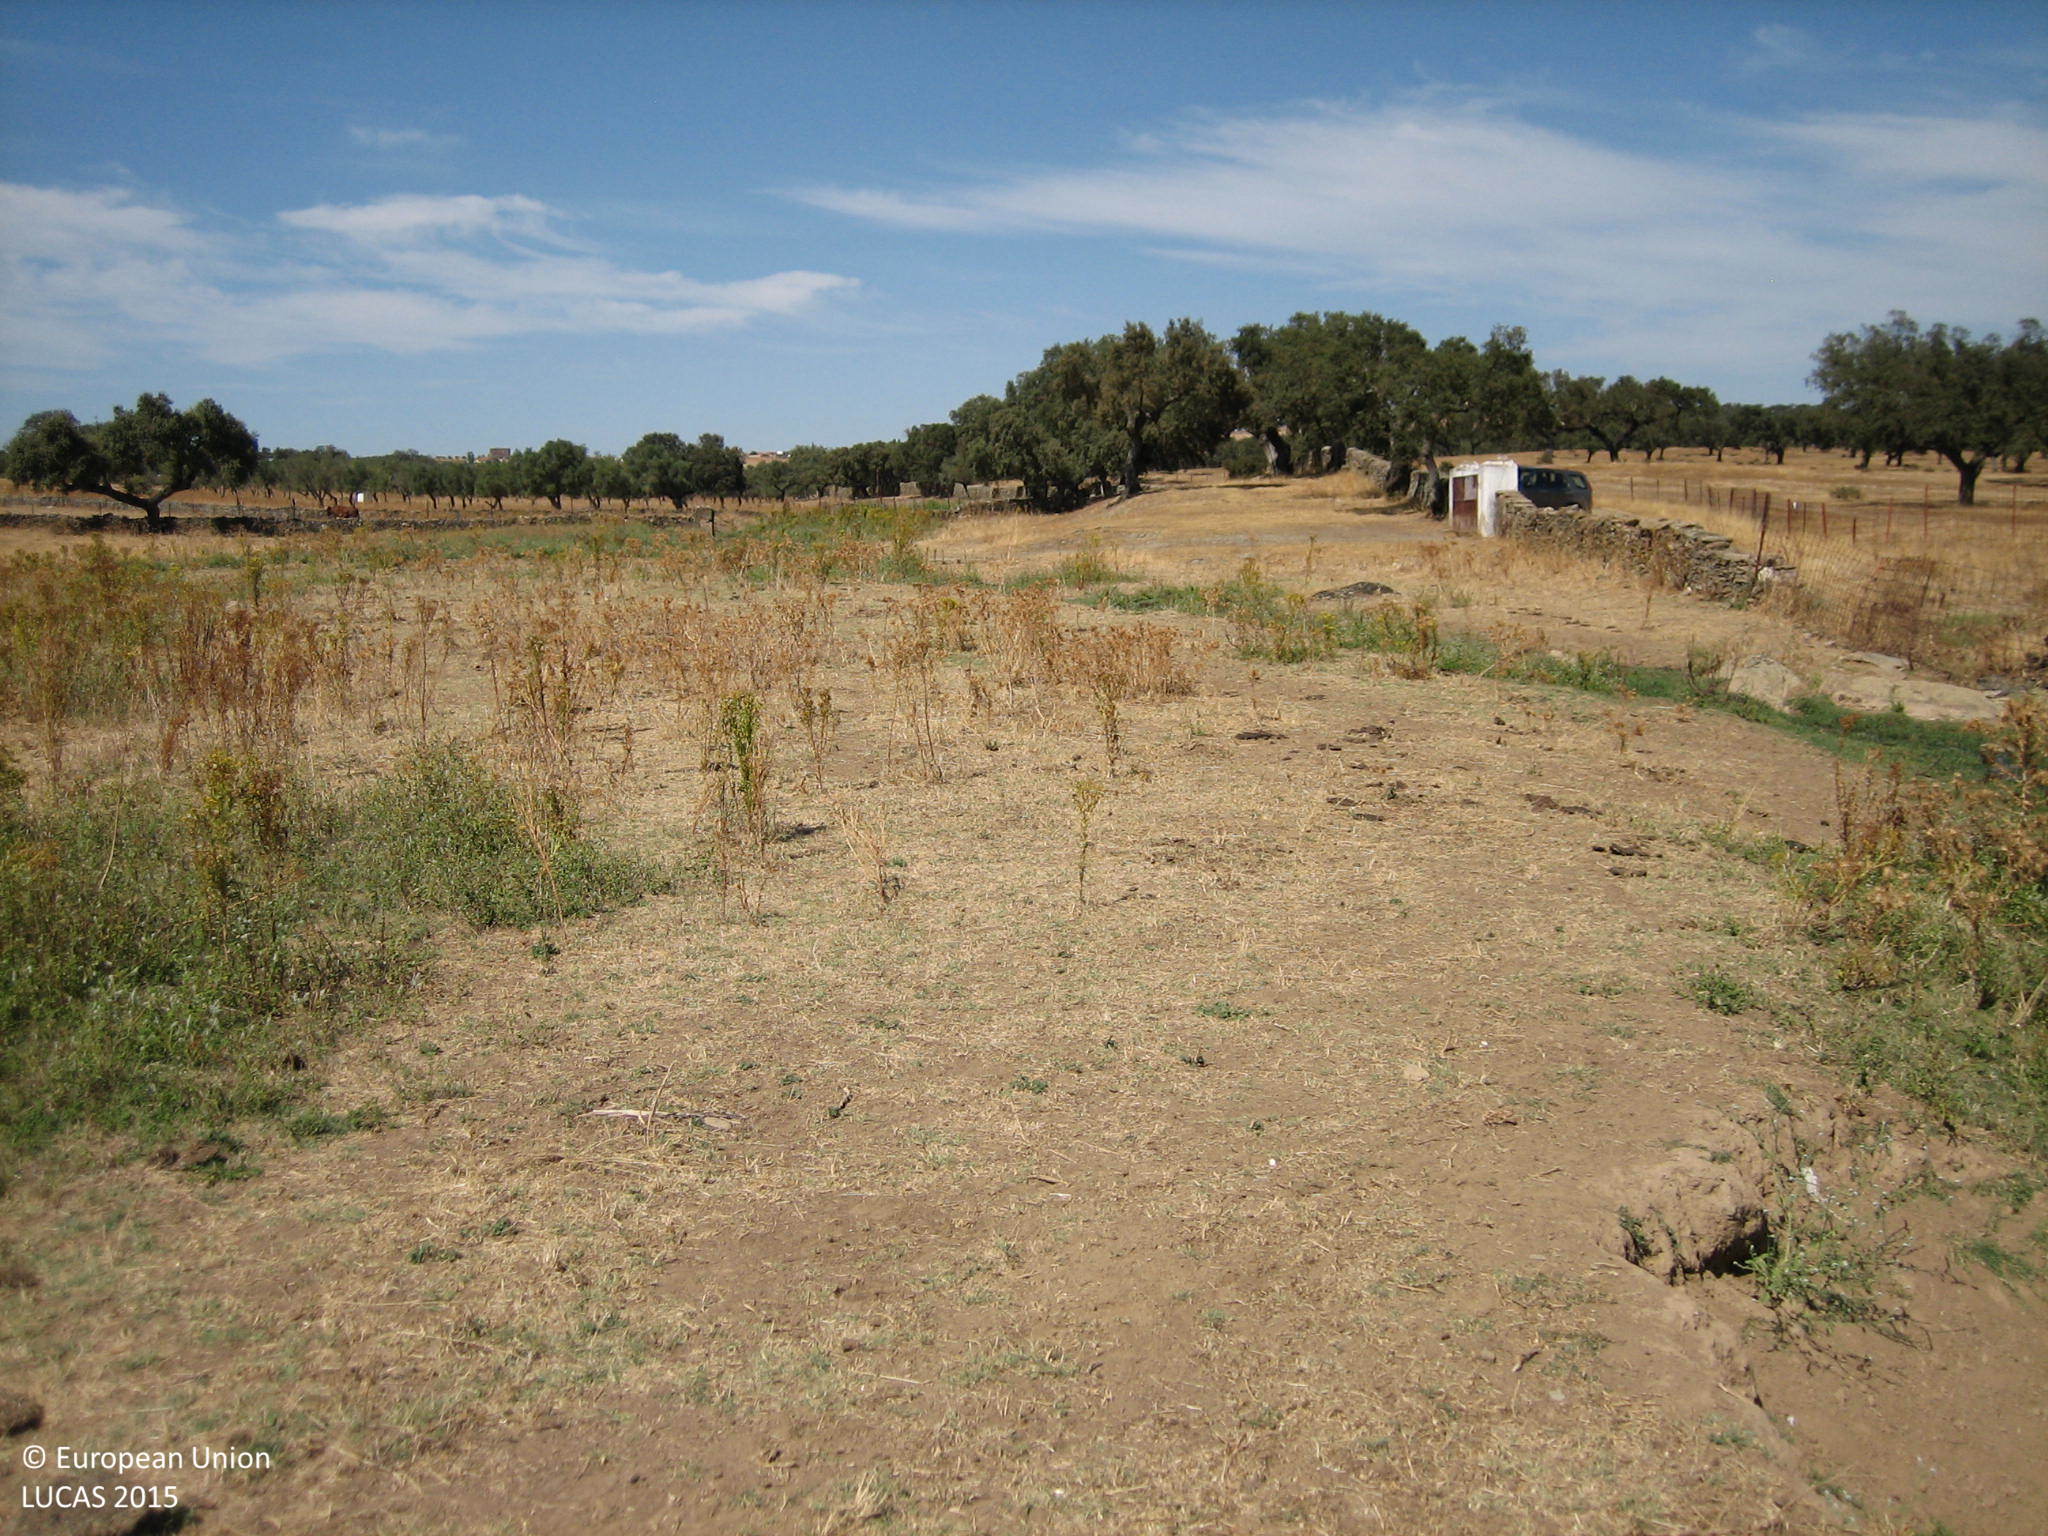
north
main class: Grassland
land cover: Grassland without tree/shrub cover
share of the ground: 50 - 75 %
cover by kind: herbaceous plants 70 %, unconsolidated bare surface 30 %
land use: Agriculture (excluding fallow land and kitchen gardens)
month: August
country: ES
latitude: 38.3529
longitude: -7.1718
